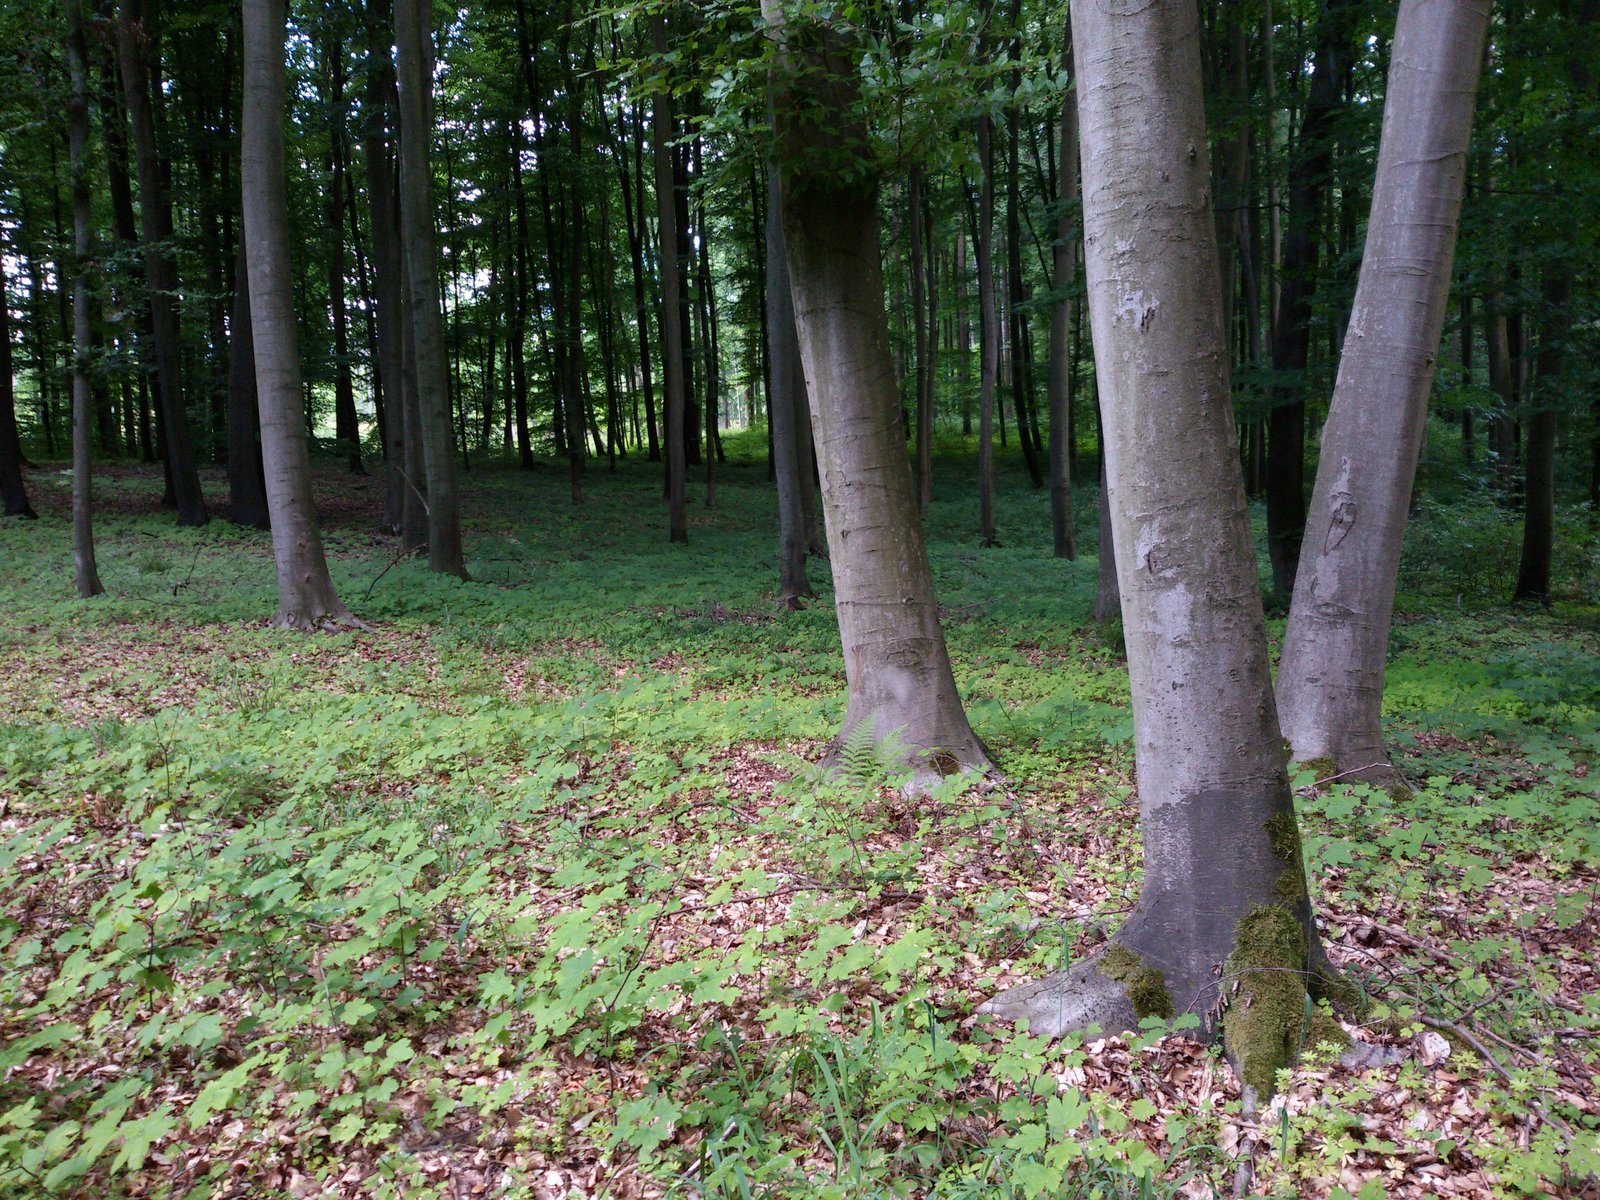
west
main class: Woodland
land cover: Broadleaved woodland
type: beech forest
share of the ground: > 75 %
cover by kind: broadleaved forest trees 95 %, herbaceous plants 5 %
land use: Forestry
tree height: > 5 m
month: June
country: PL
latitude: 52.6775
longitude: 16.9759
